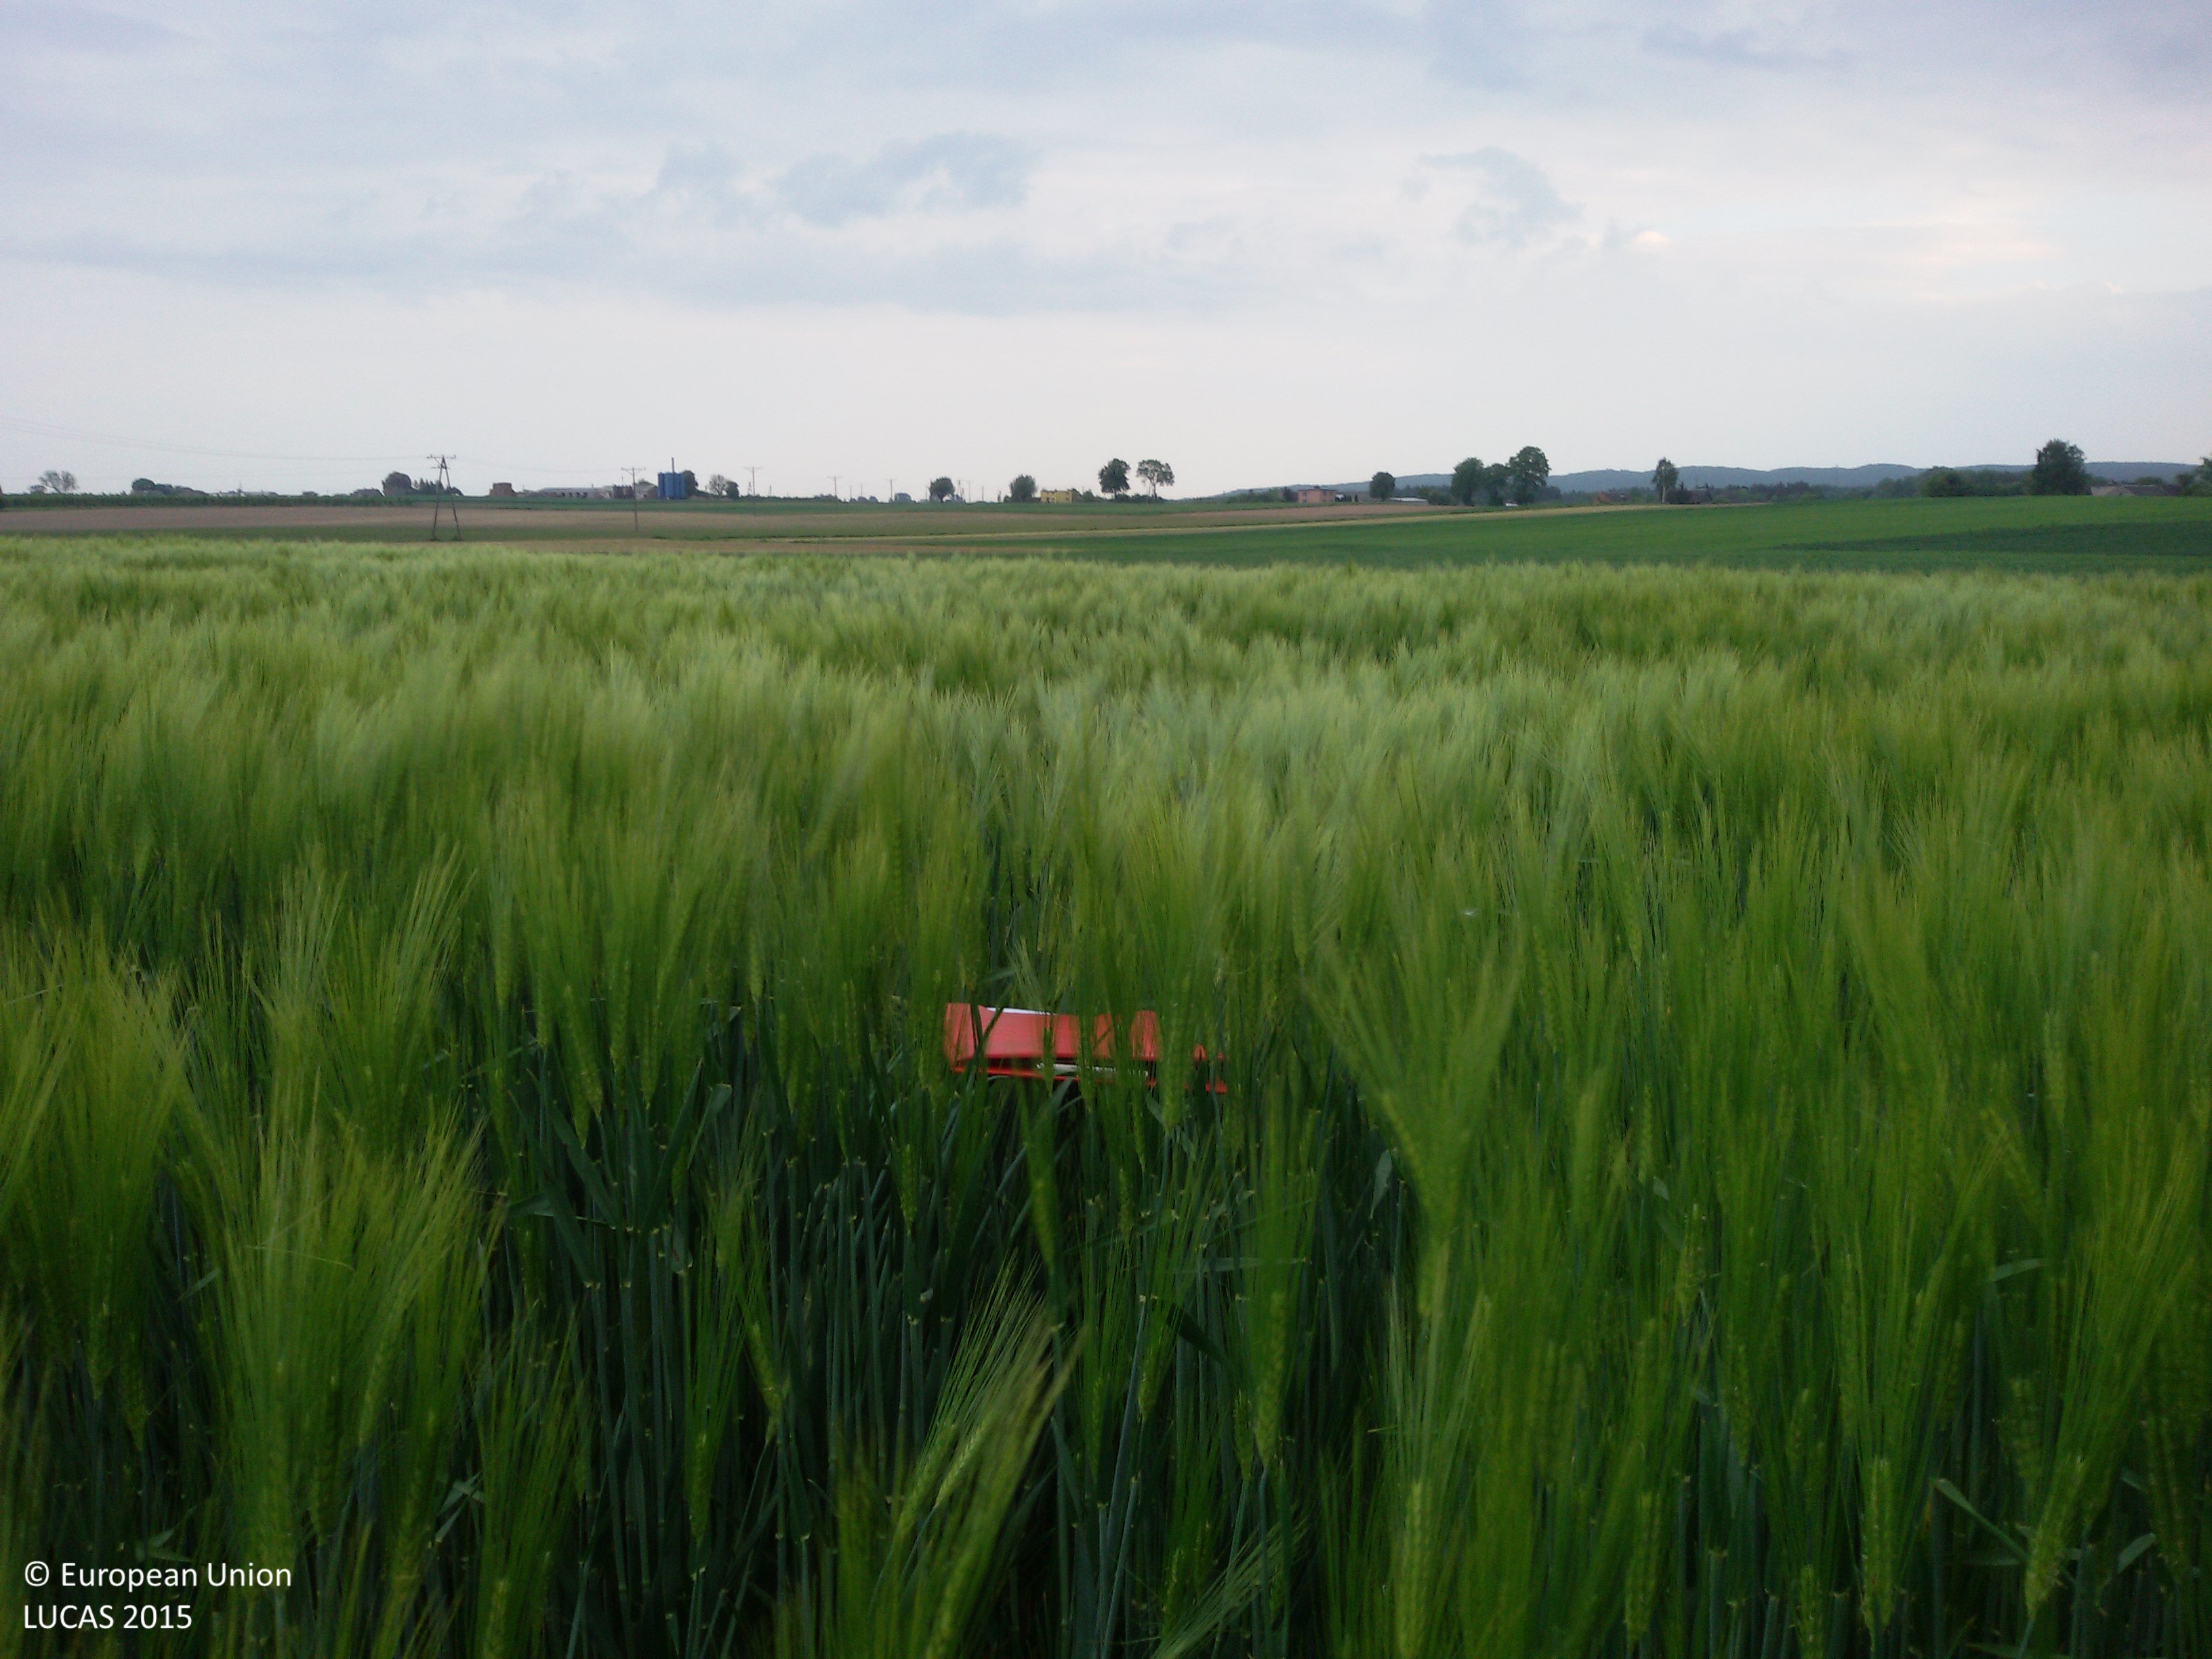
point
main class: Cropland
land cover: Barley
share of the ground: > 75 %
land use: Agriculture (excluding fallow land and kitchen gardens)
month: May
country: PL
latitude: 53.1853
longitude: 17.2385
